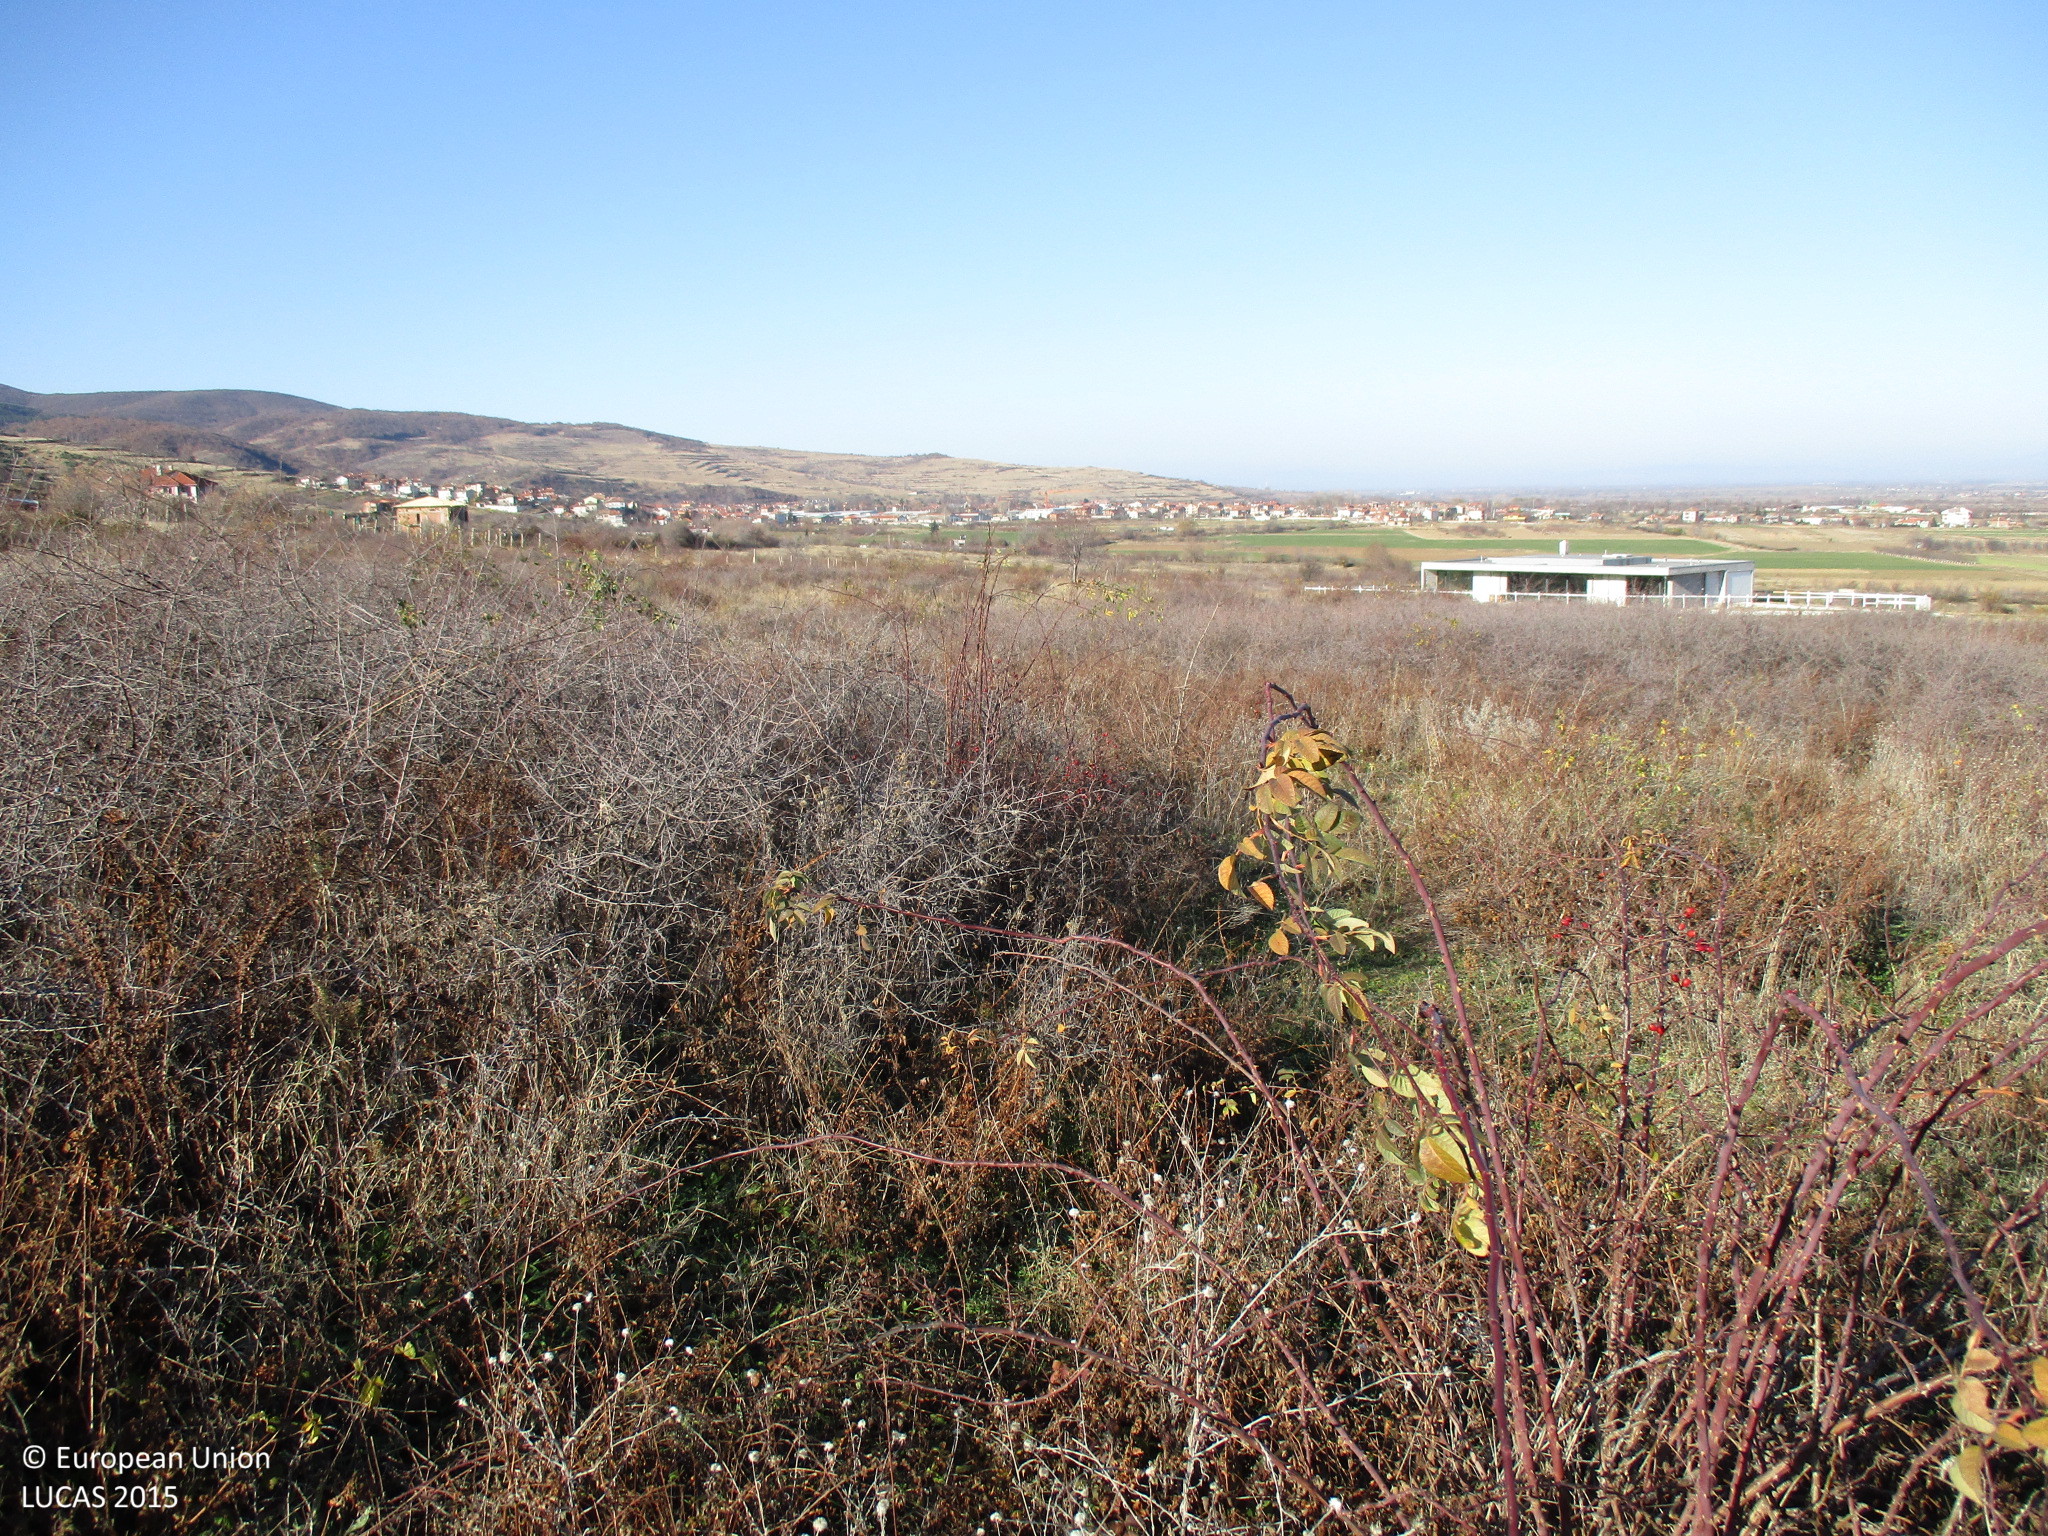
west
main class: Shrubland
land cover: Shrubland without tree cover
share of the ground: > 75 %
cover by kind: shrubs 70 %, herbaceous plants 30 %
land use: Semi-natural and natural areas not in use
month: December
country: BG
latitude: 42.0717
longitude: 24.6860
